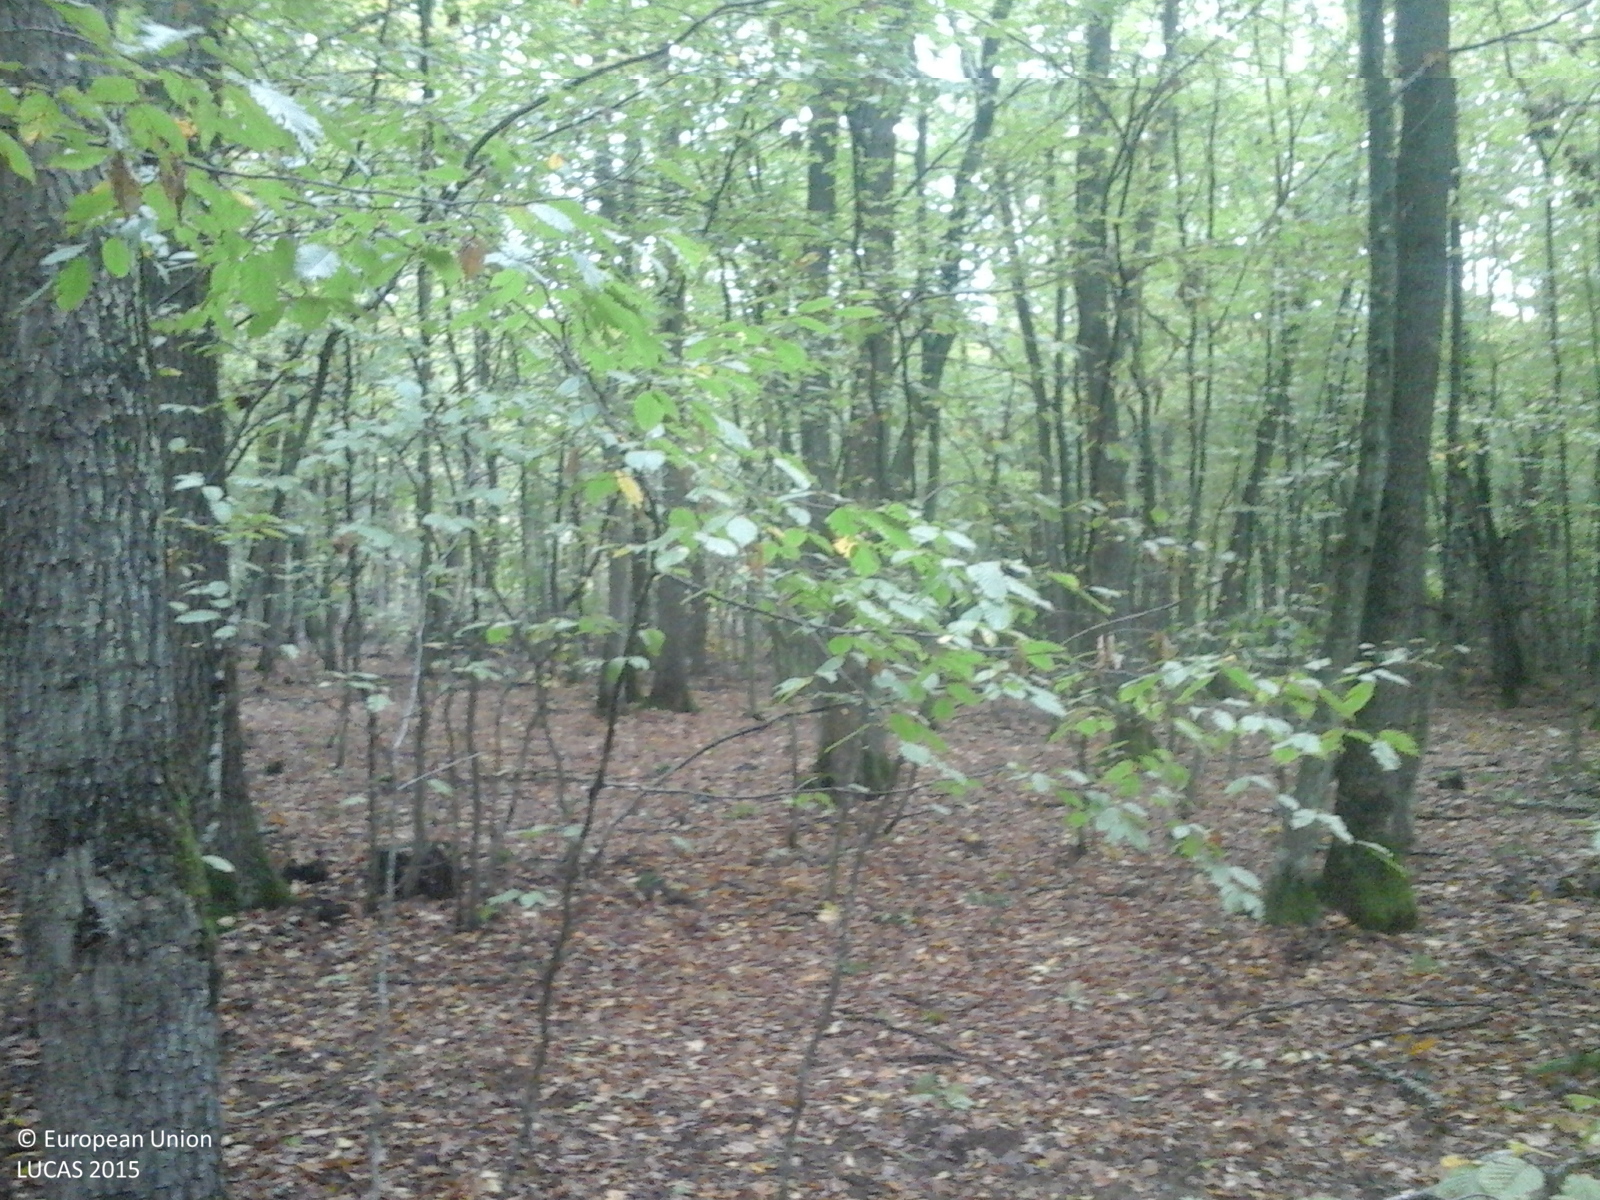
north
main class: Woodland
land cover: Broadleaved woodland
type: acidophilous oak and oak-birch forest
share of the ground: > 75 %
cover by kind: broadleaved forest trees 100 %
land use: Forestry
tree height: > 5 m
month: October
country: RO
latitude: 45.8620
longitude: 24.8110
